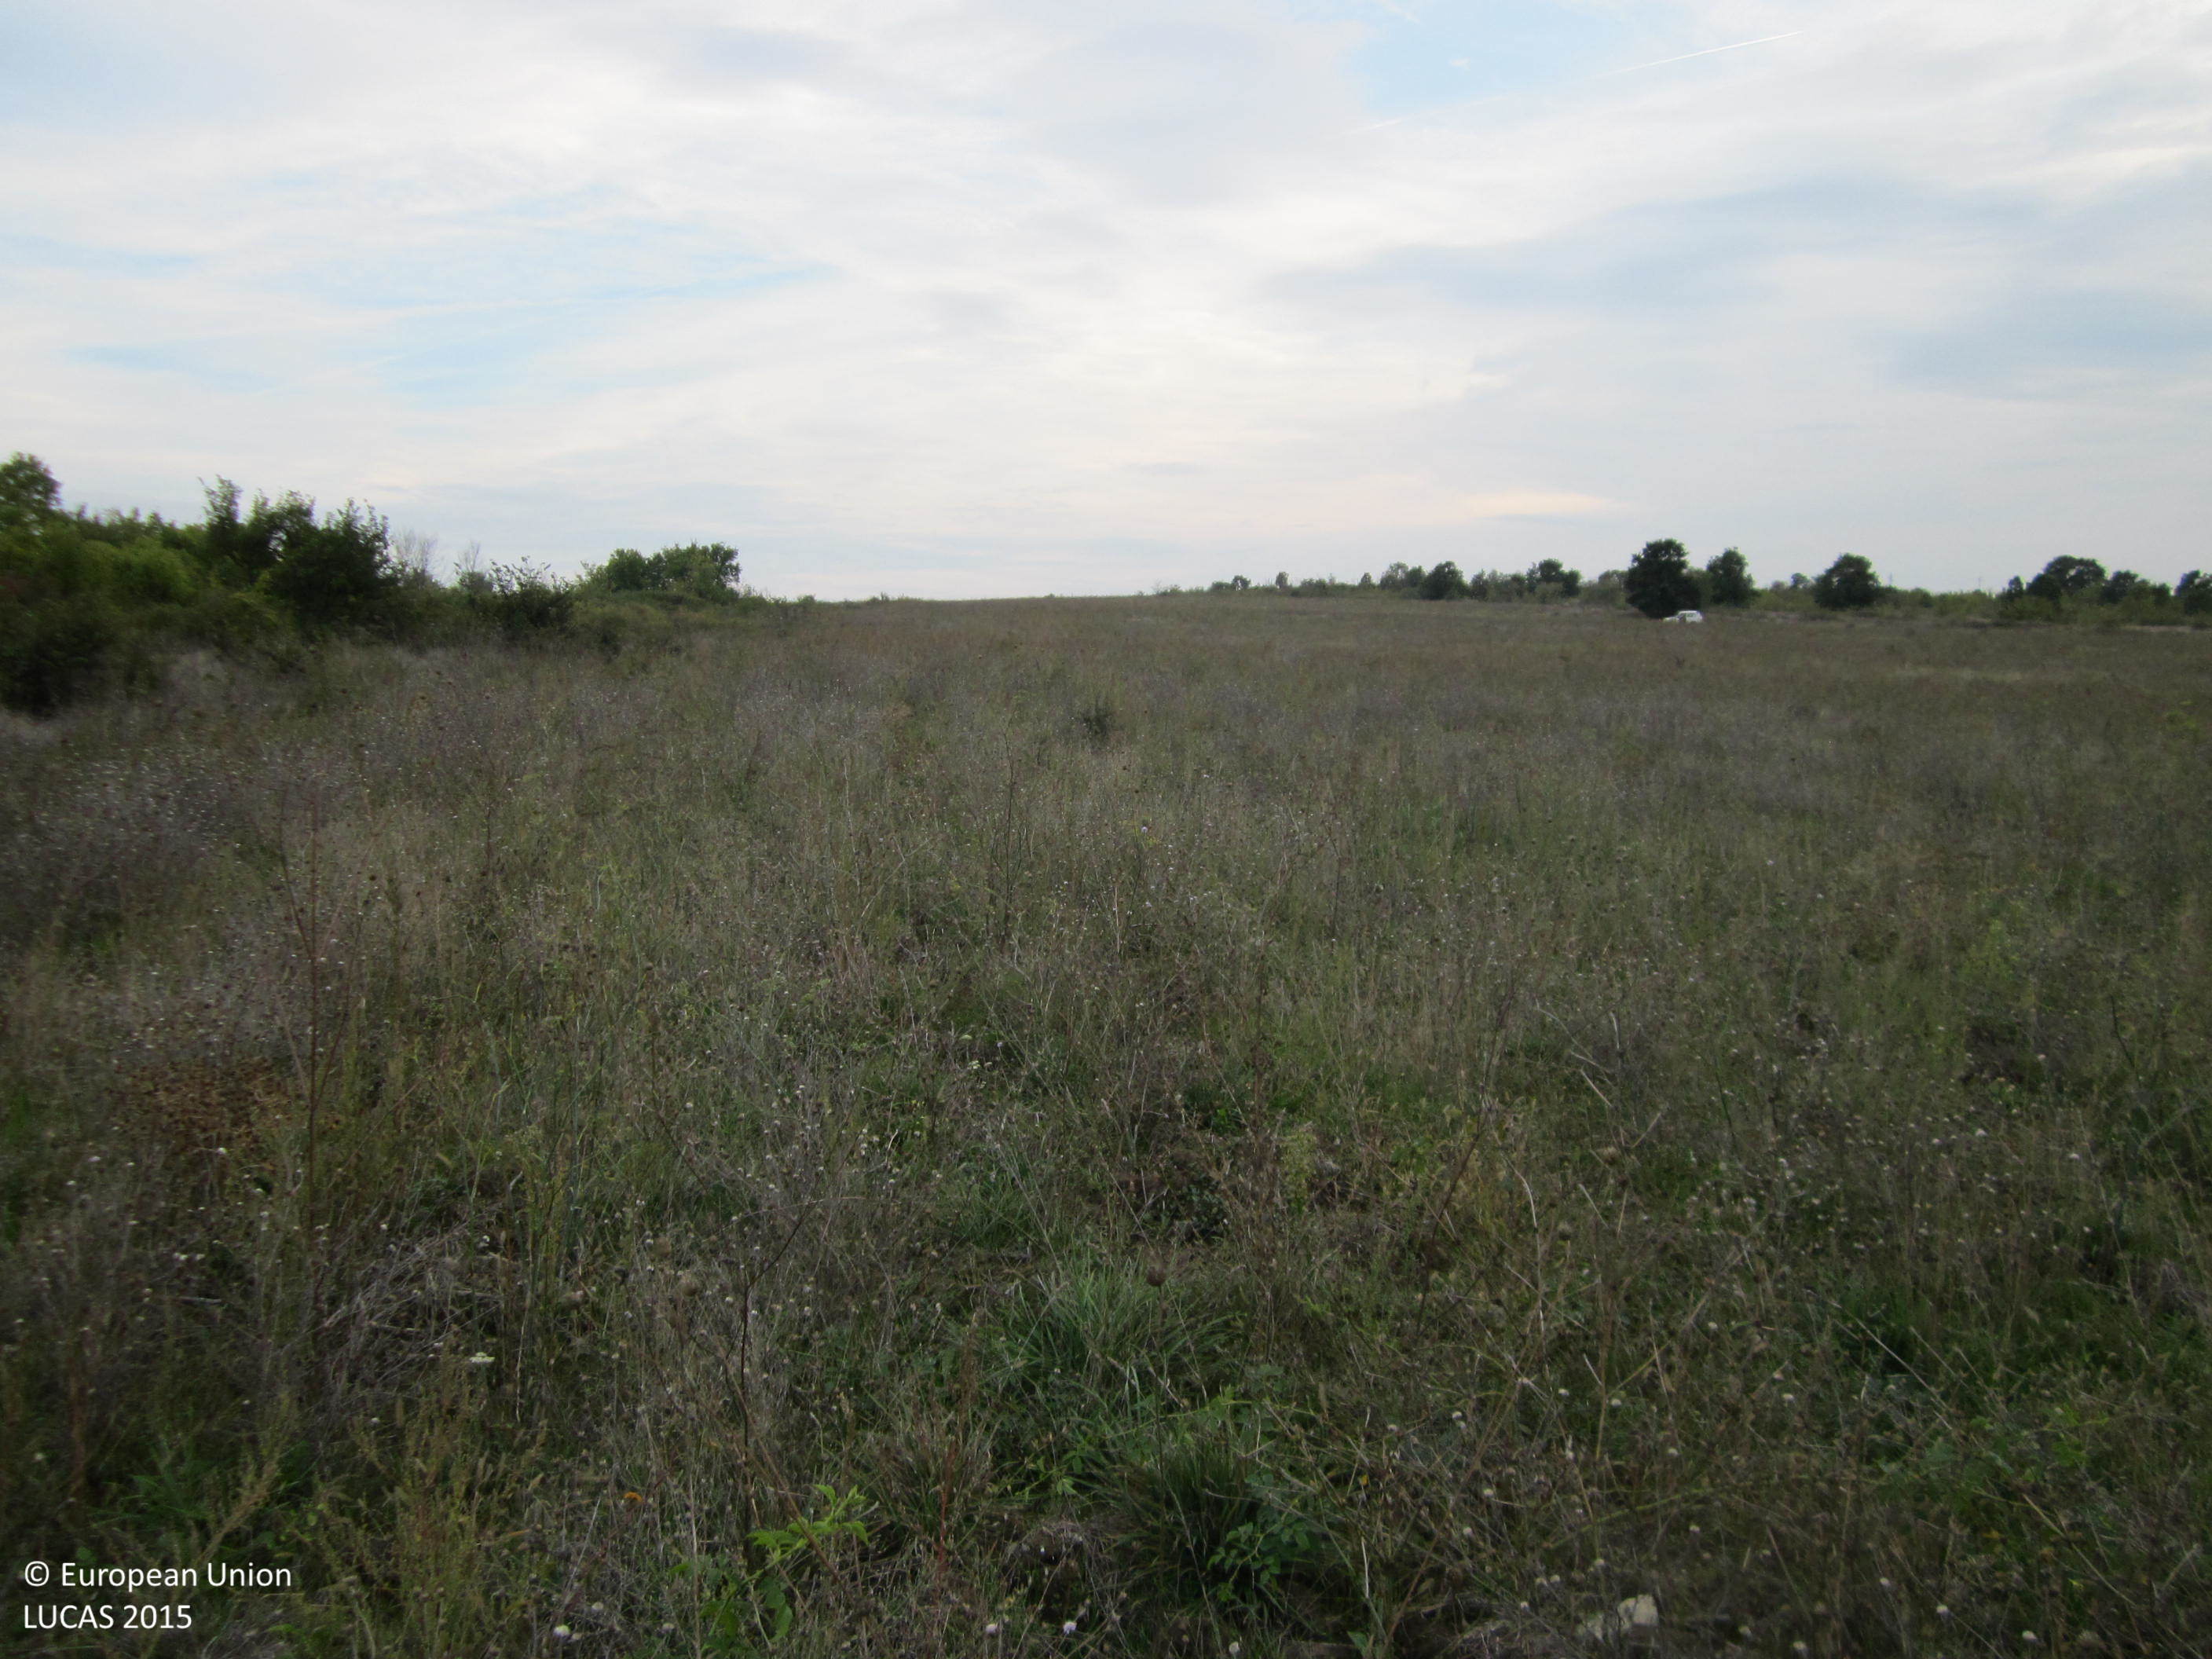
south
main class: Grassland
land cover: Grassland without tree/shrub cover
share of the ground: > 75 %
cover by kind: herbaceous plants 100 %
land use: Agriculture (excluding fallow land and kitchen gardens)
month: October
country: BG
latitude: 42.7124
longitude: 26.7932
